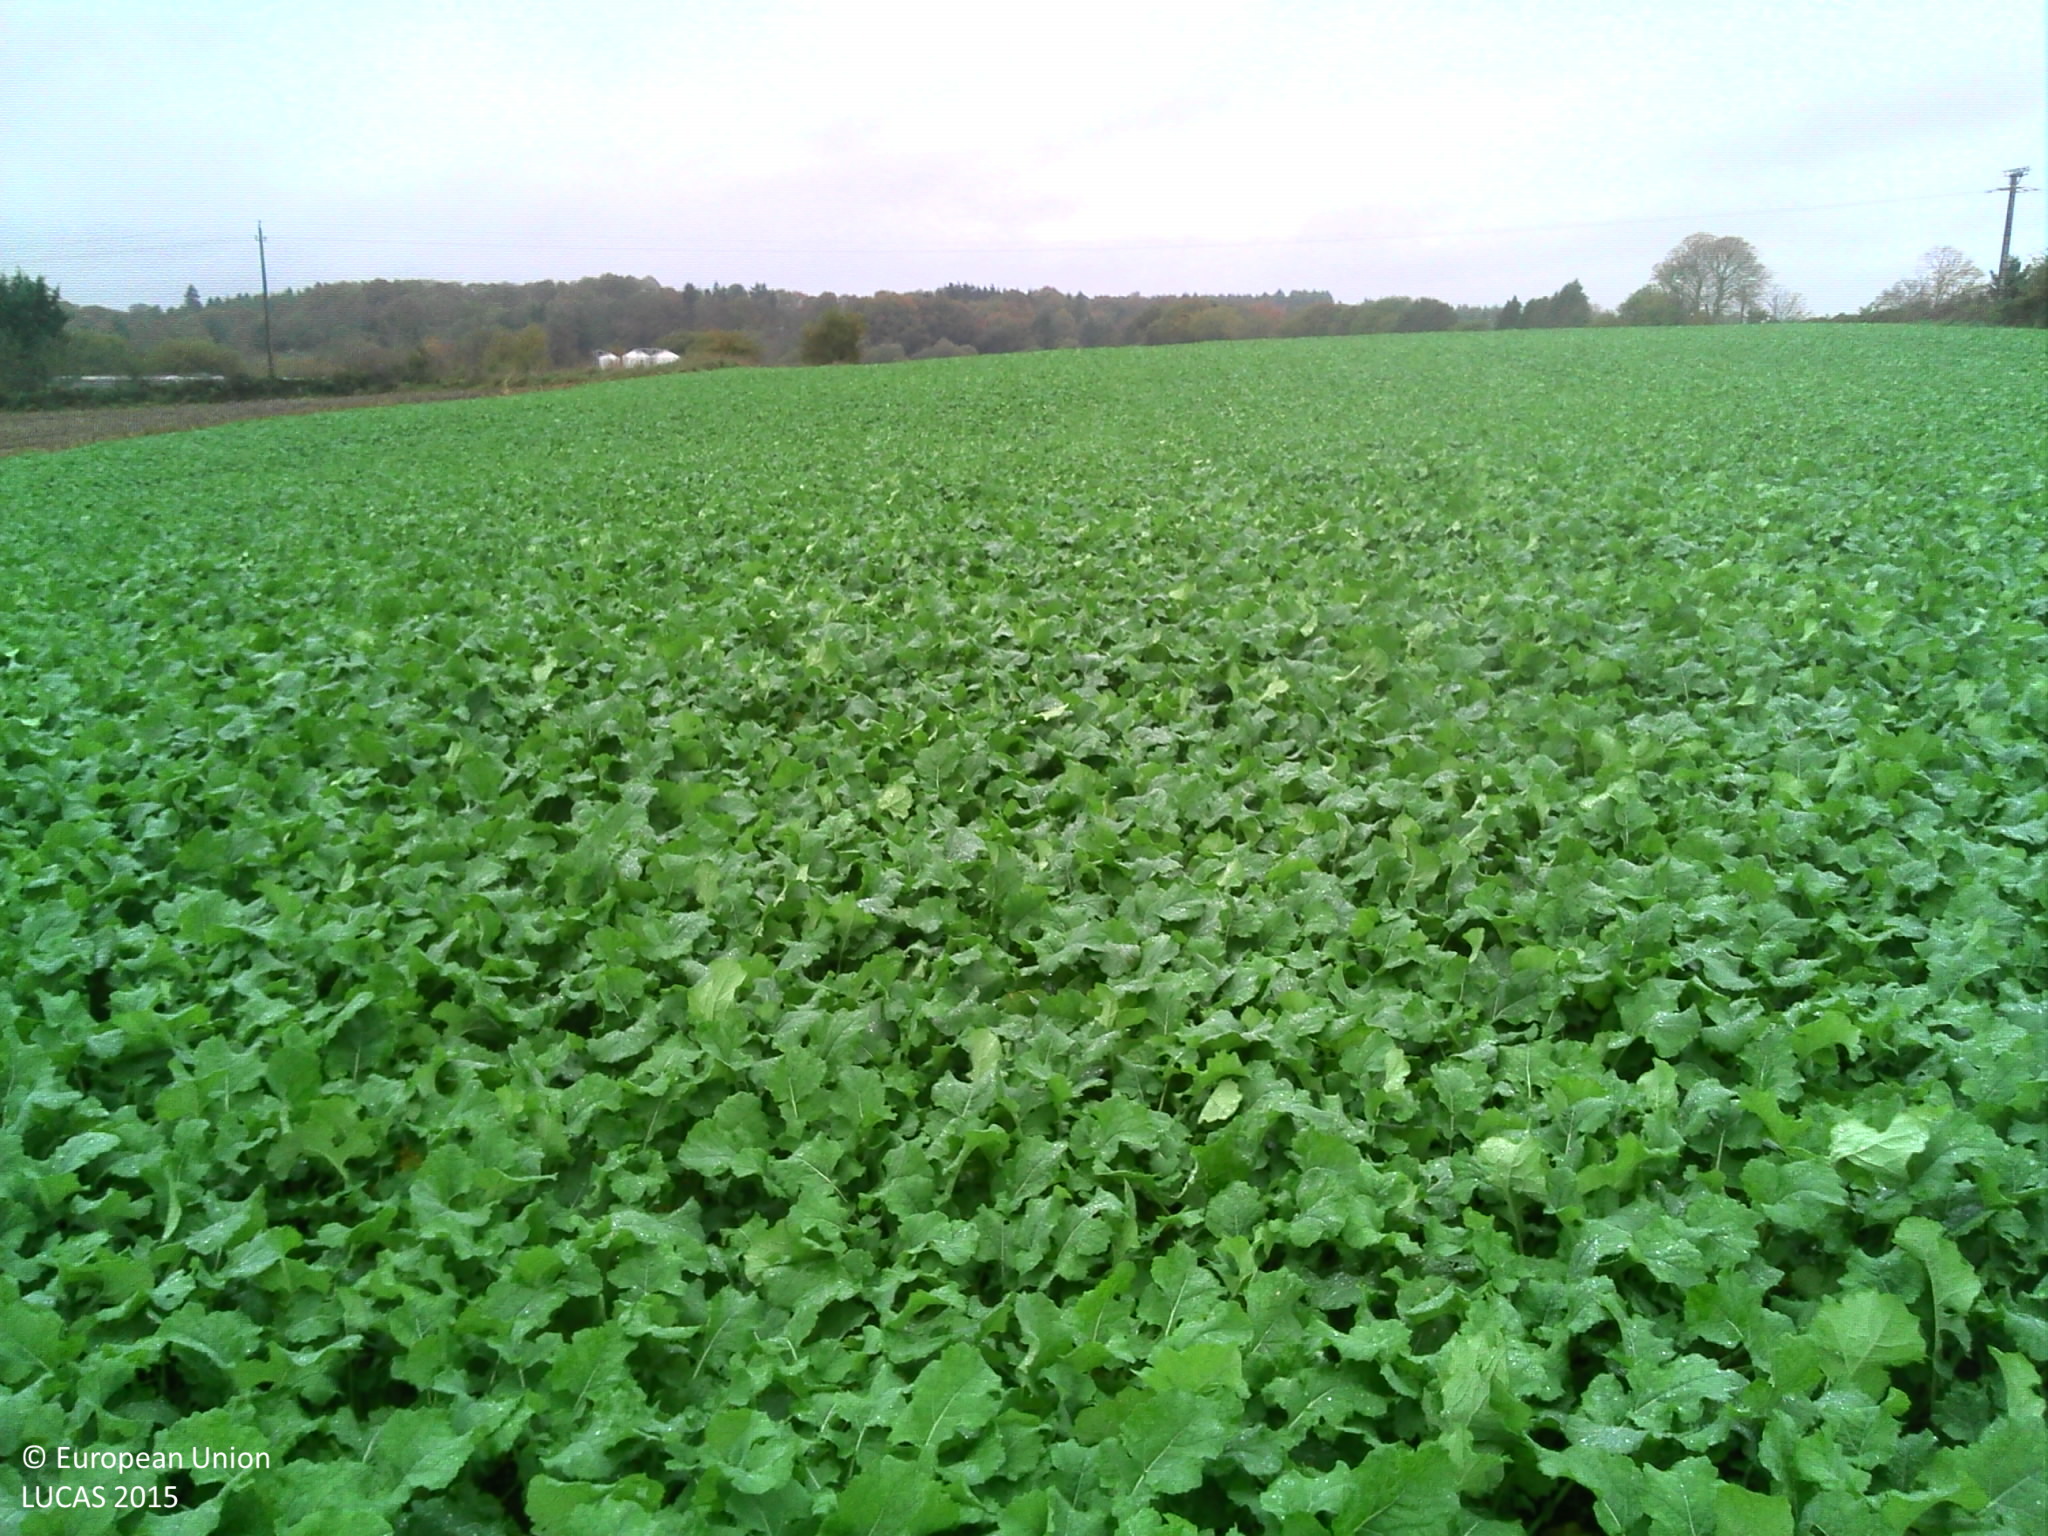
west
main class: Cropland
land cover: Rape and turnip rape
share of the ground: > 75 %
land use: Agriculture (excluding fallow land and kitchen gardens)
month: November
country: FR
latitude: 47.9502
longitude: -3.2336
